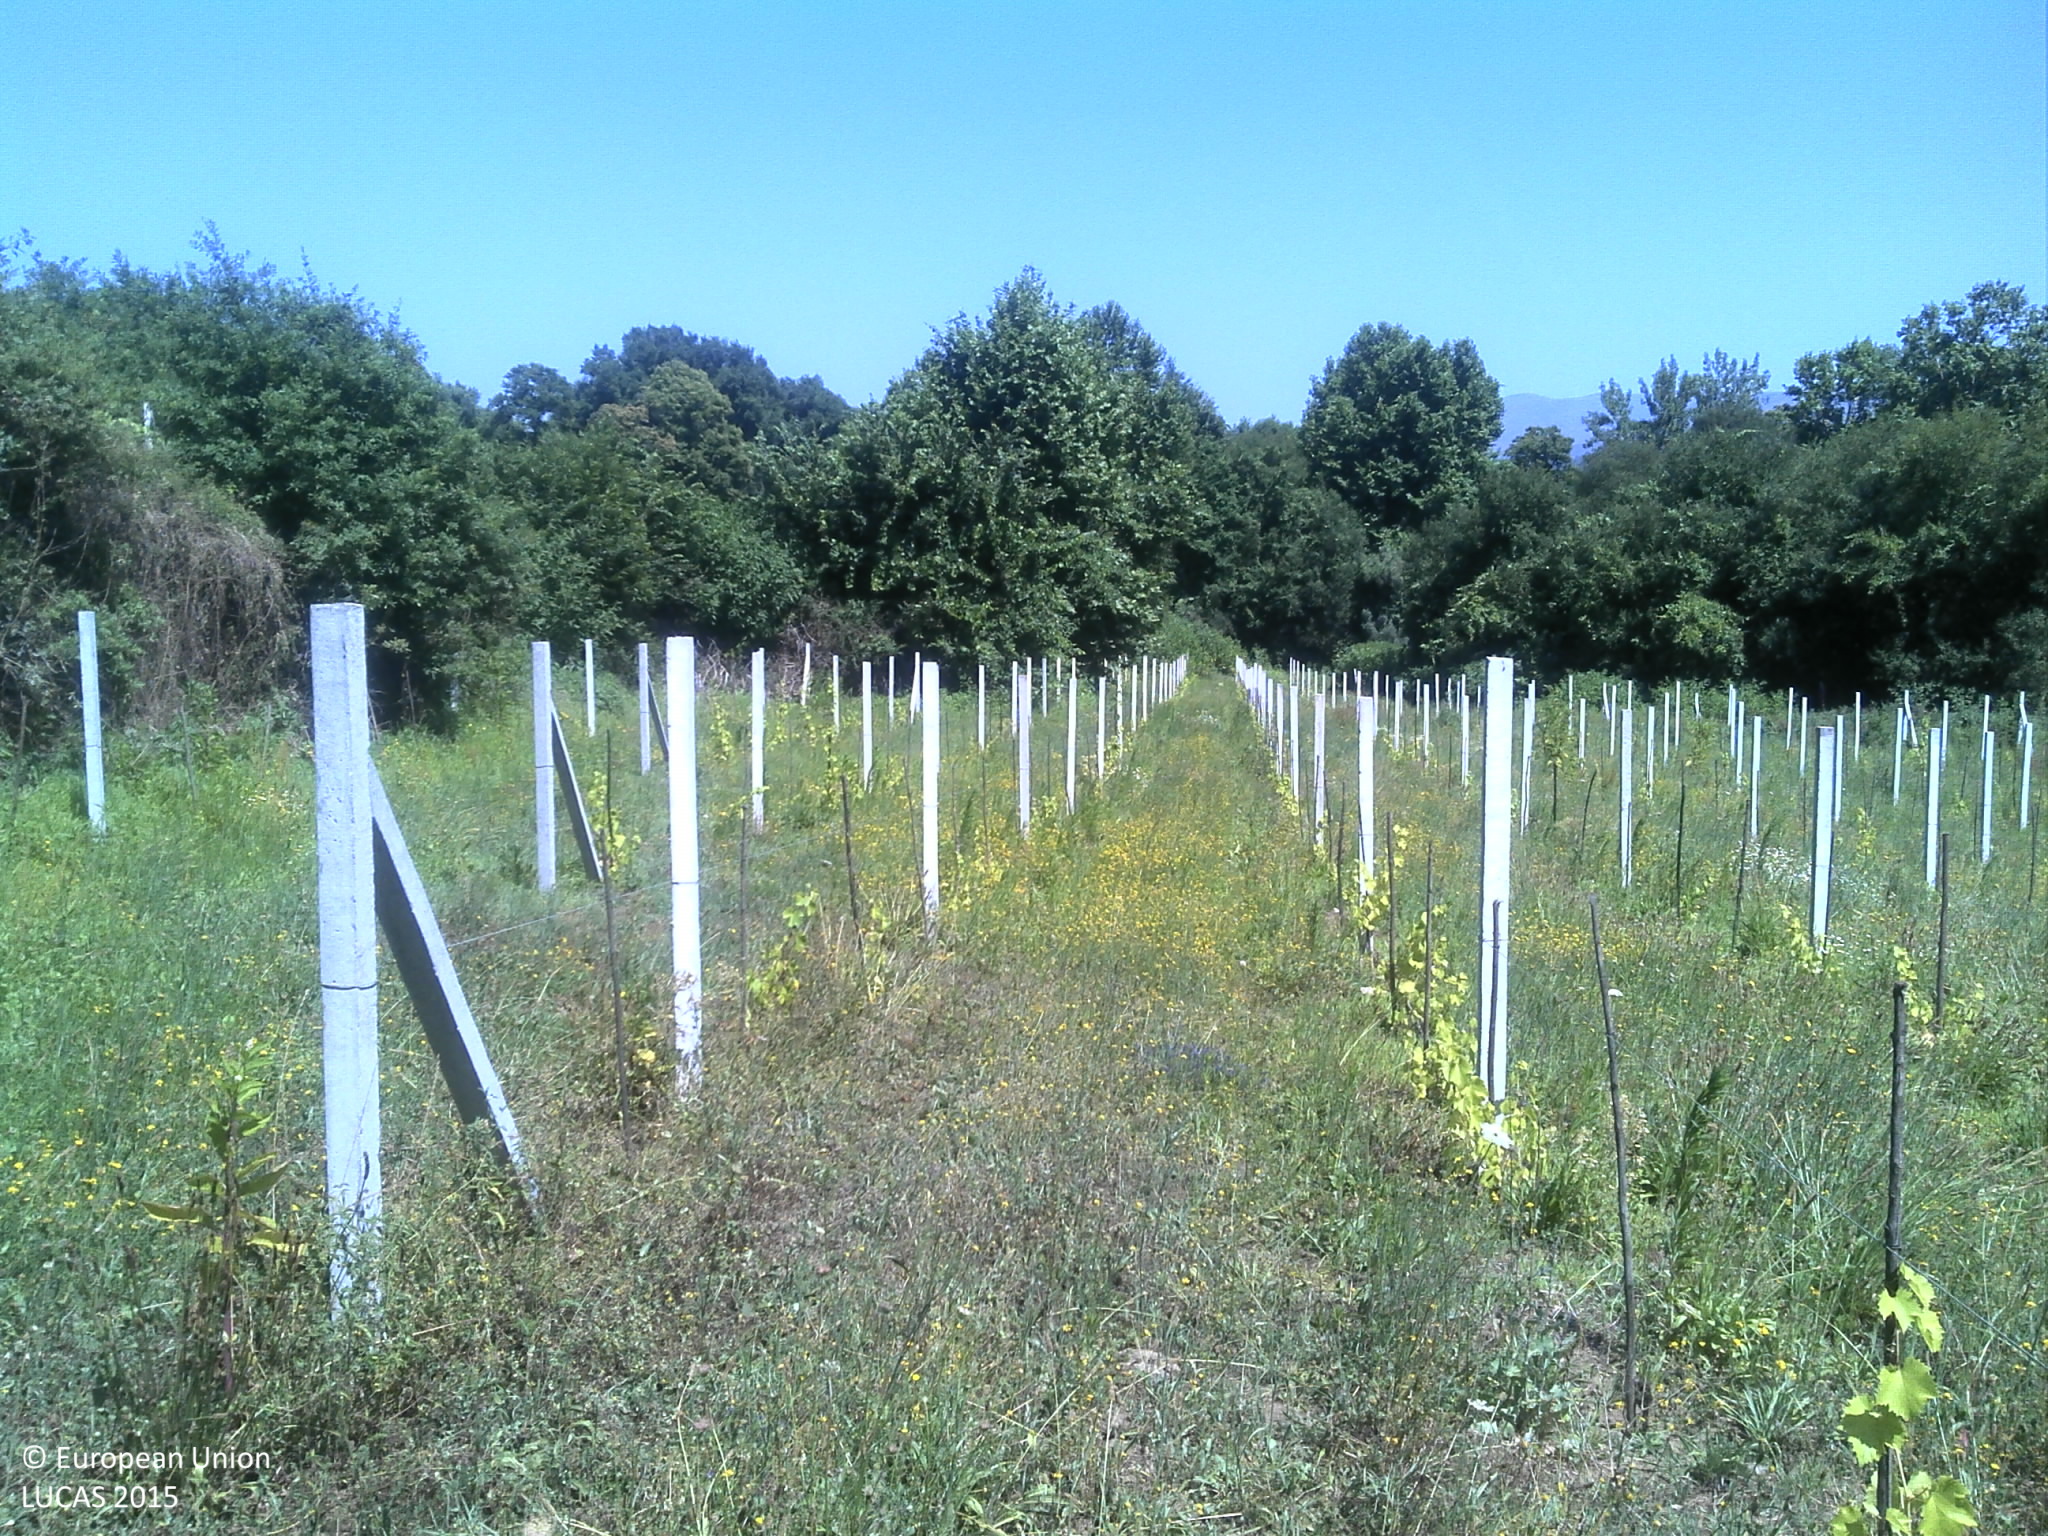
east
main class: Cropland
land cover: Vineyards
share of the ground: 10 - 25 %
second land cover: Grassland without tree/shrub cover
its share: > 75 %
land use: Agriculture (excluding fallow land and kitchen gardens)
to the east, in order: Vineyards; Grassland without tree/shrub cover; Vineyards; Dry stone walls; Vineyards; Grass margins; Tracks; Dry stone walls; Other bare soil; Single bushes/trees; Dry stone walls; Grassland without tree/shrub cover; Artificial constructions in urban areas; Broadleaved woodland
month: June
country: PT
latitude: 41.3346
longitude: -8.0267
